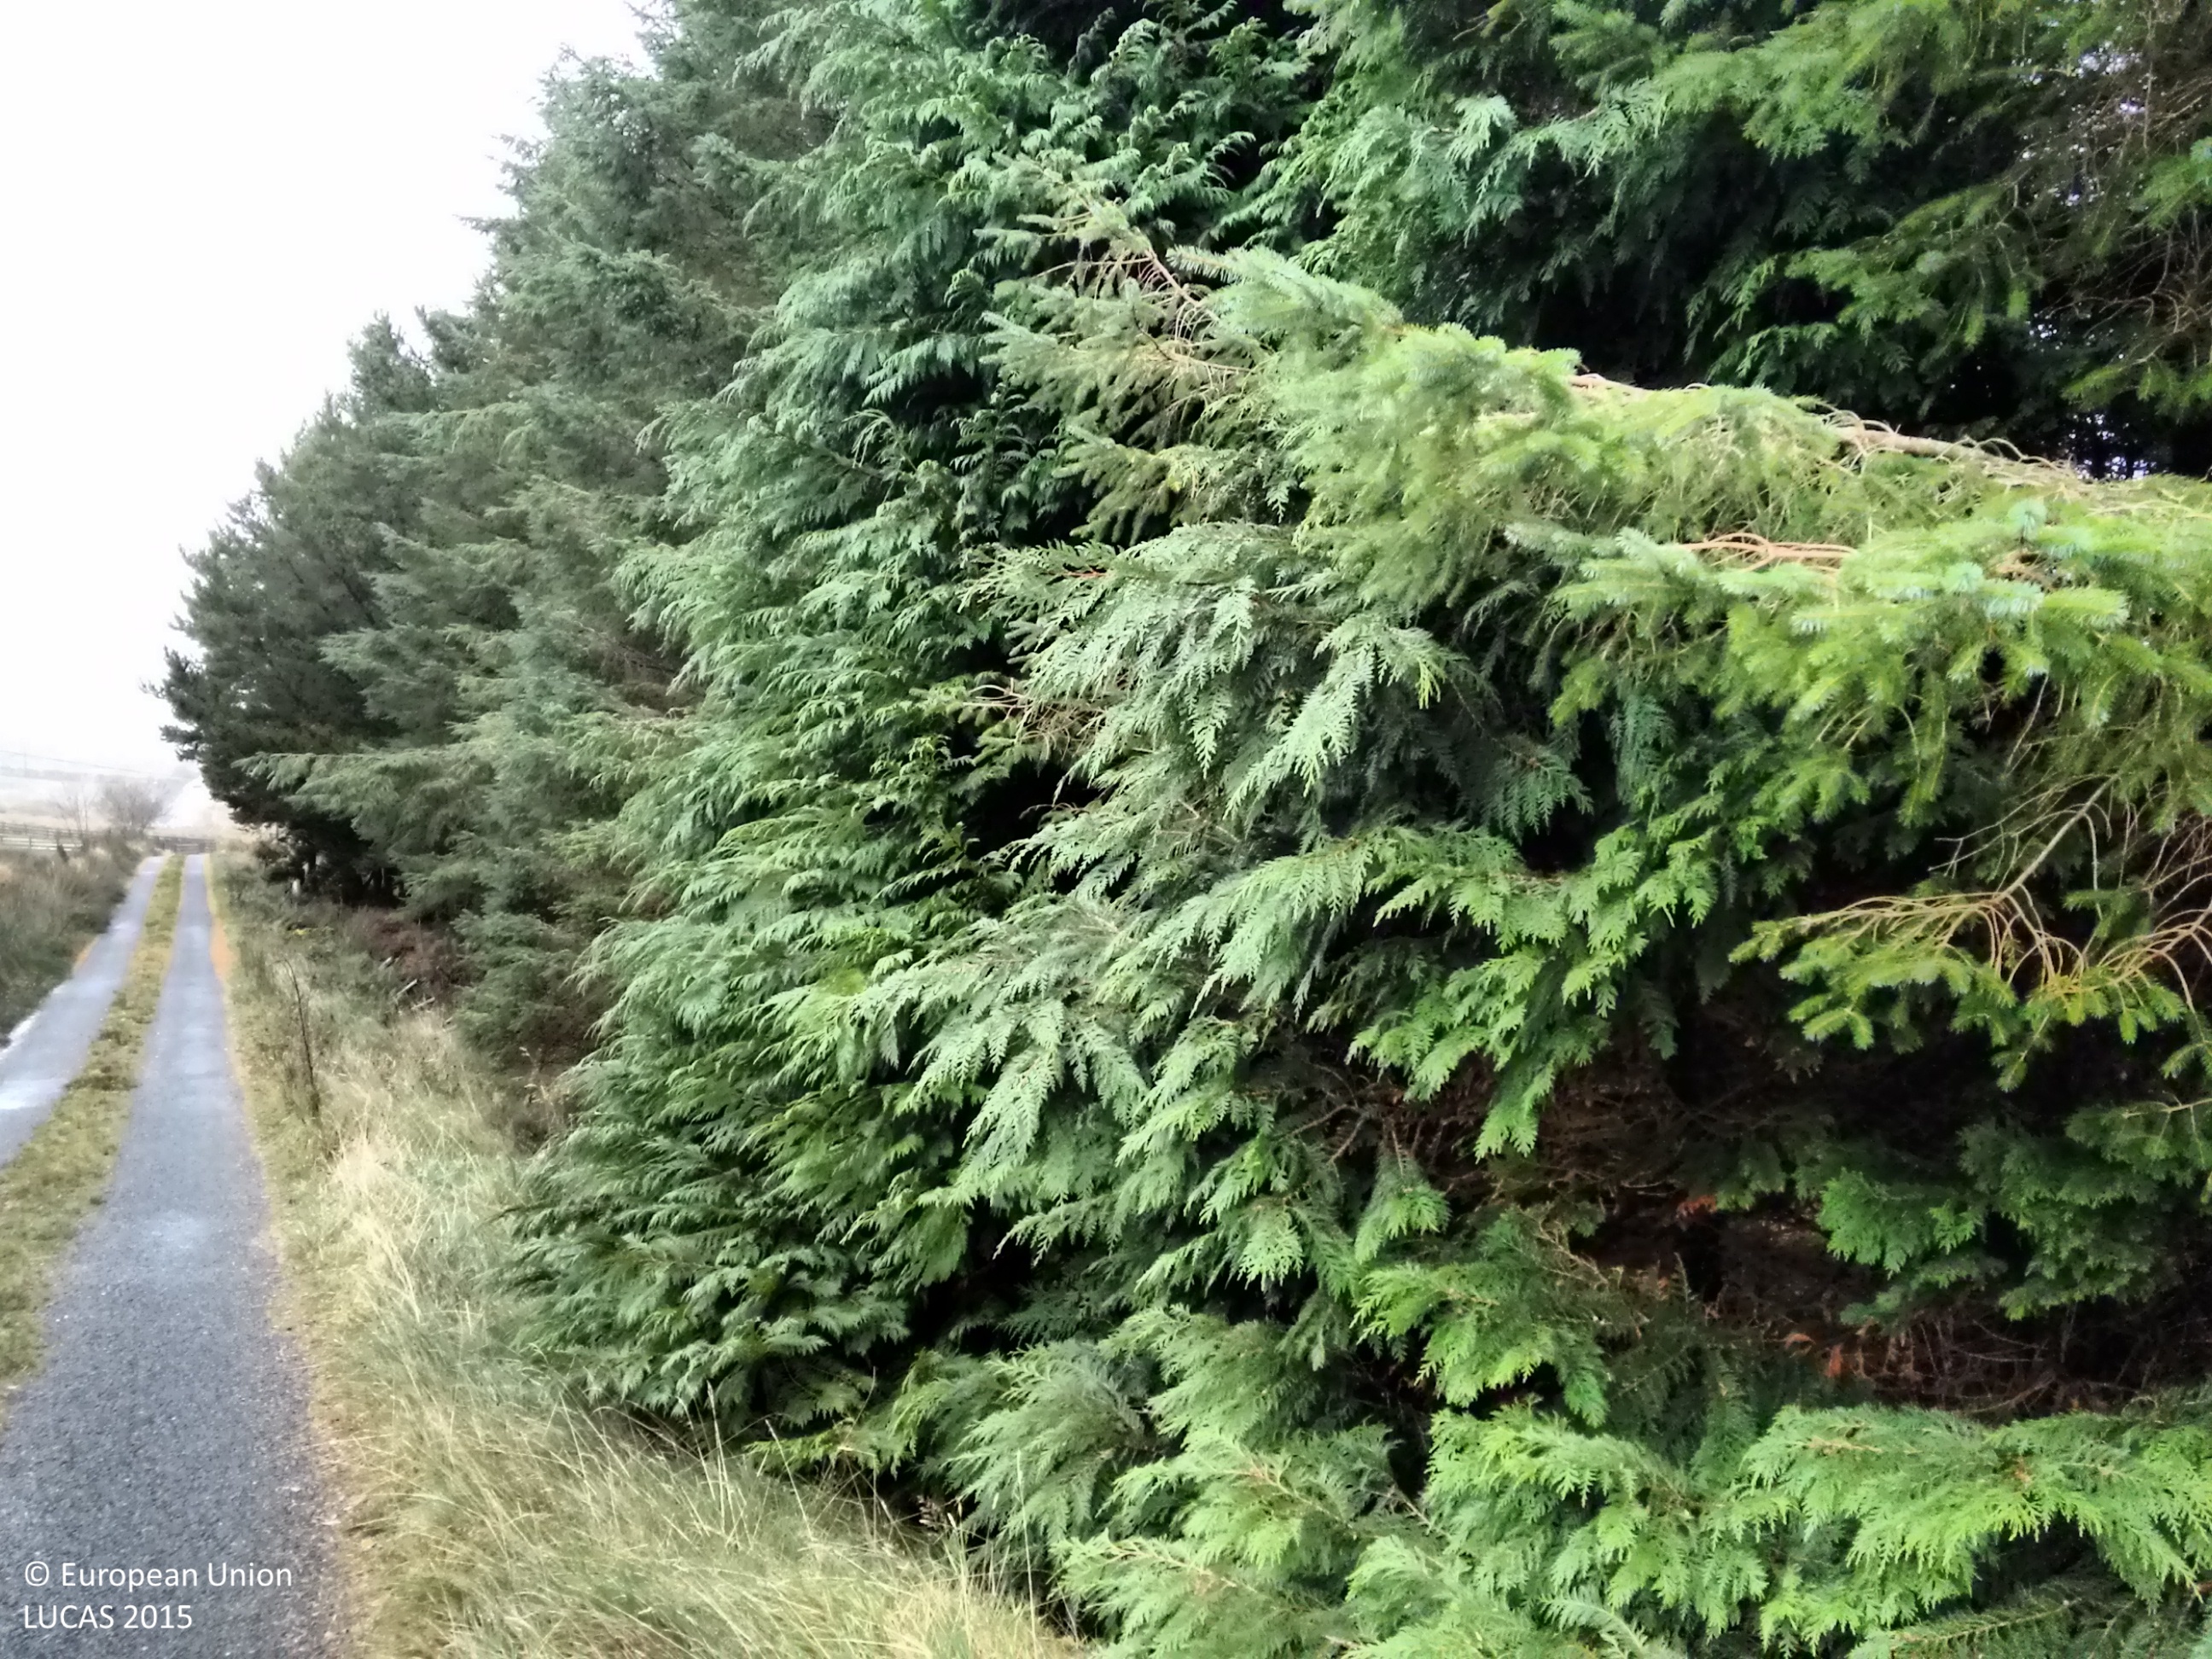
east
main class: Woodland
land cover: Spruce dominated coniferous woodland
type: exotic forest
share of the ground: > 75 %
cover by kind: coniferous forest trees 90 %, herbaceous plants 10 %
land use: Forestry
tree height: > 5 m
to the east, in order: Spruce dominated coniferous woodland; Artificial constructions in urban areas; Grassland without tree/shrub cover; Fences; Grassland without tree/shrub cover
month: November
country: IE
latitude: 54.8239
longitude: -8.2517
